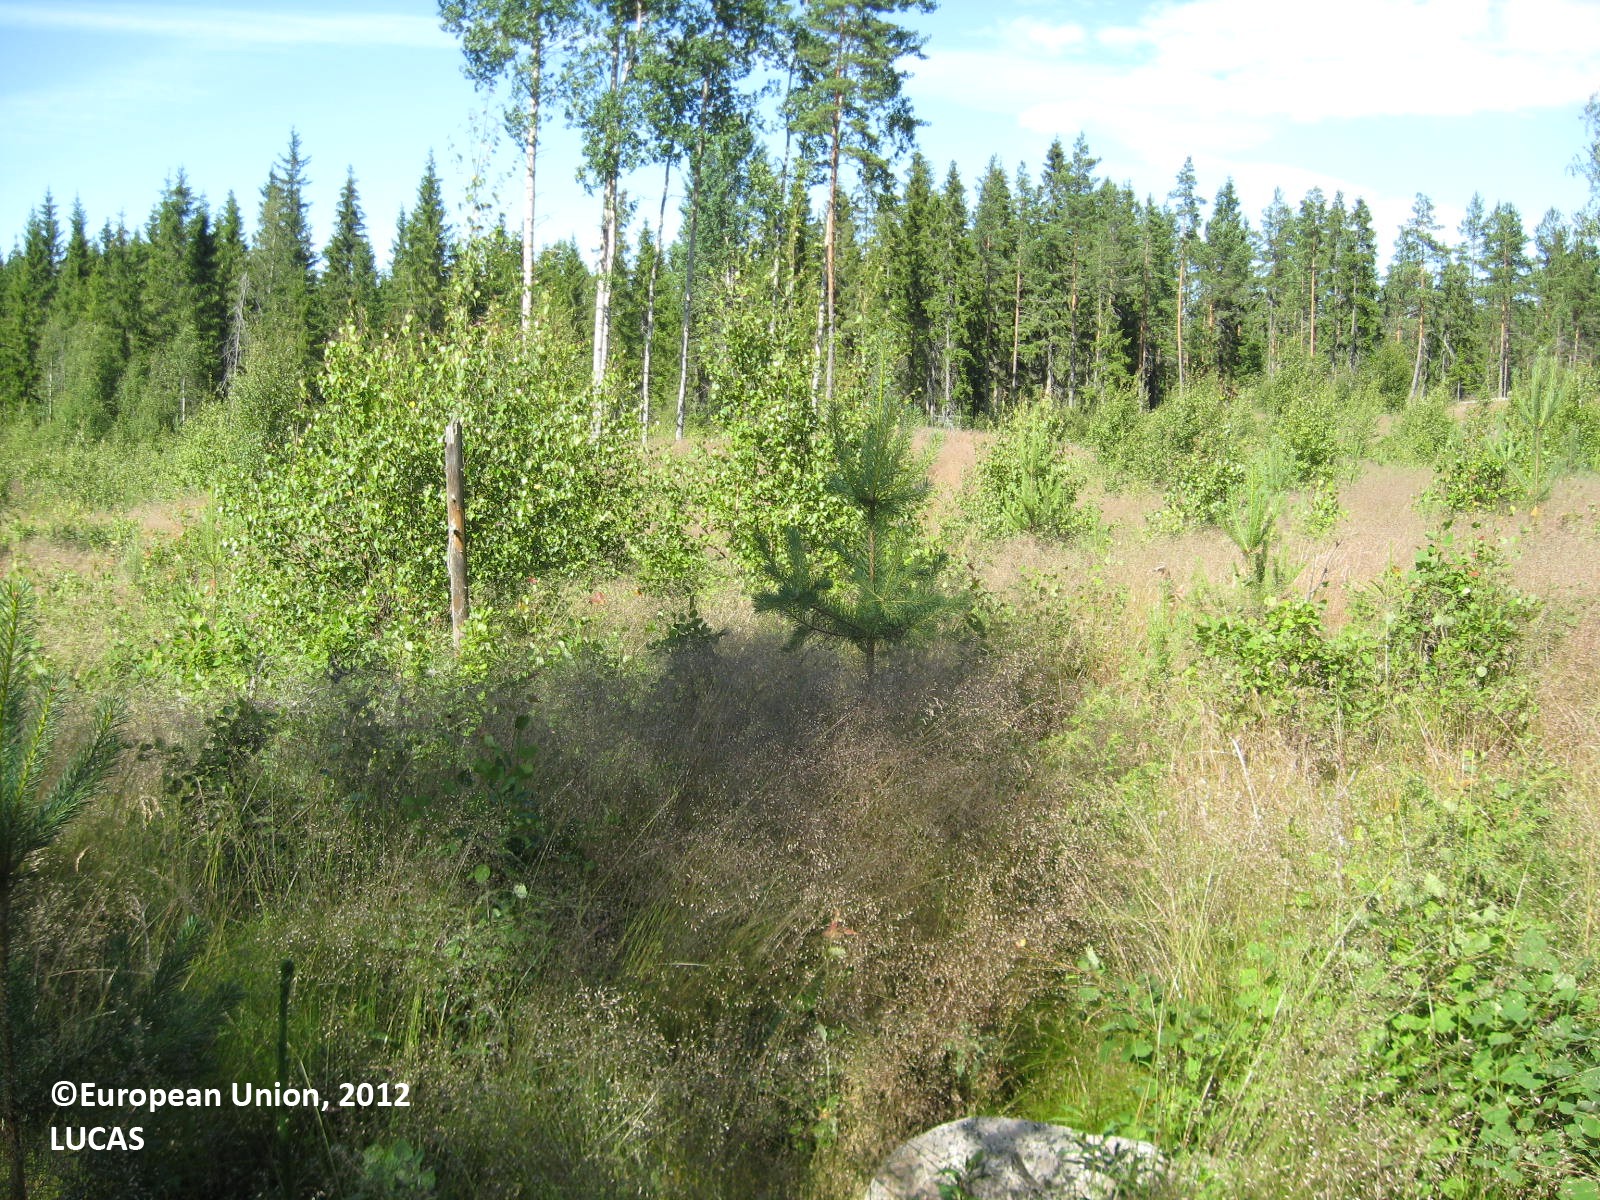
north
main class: Woodland
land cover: Other mixed woodland
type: boreal forest
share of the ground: 10 - 25 %
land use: Forestry
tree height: < 5 m
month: July
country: FI
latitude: 62.0987
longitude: 21.4821
